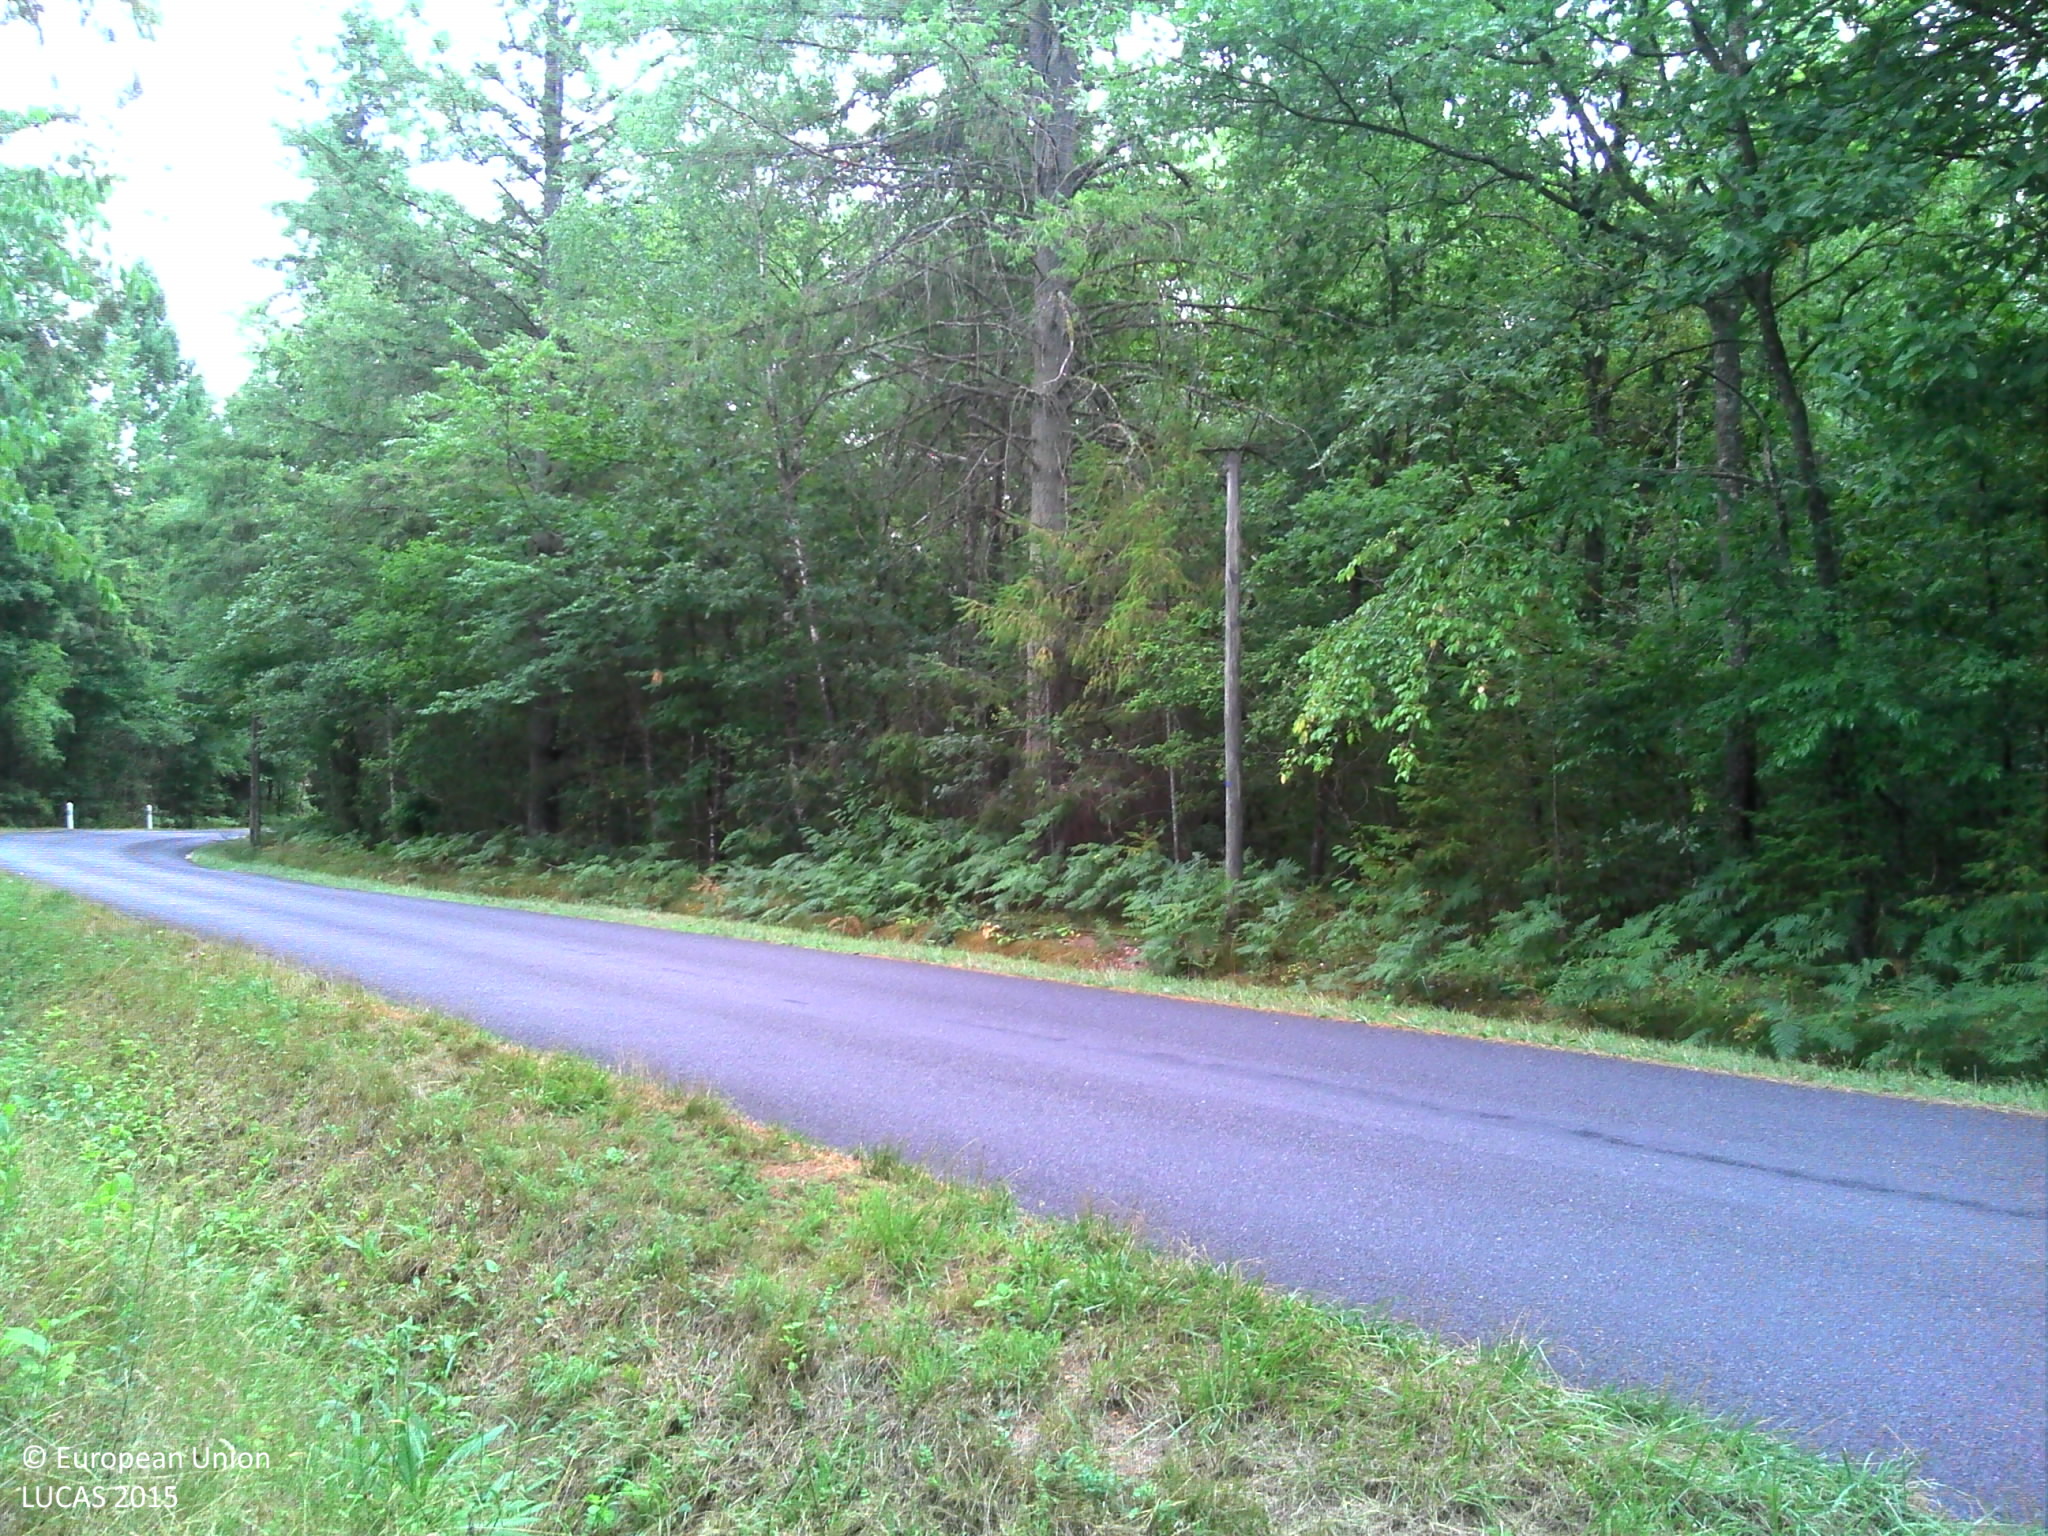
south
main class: Woodland
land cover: Broadleaved woodland
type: acidophilous oak and oak-birch forest
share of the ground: > 75 %
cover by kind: broadleaved forest trees 100 %
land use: Forestry
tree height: > 5 m
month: July
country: FR
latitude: 47.6820
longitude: 2.0362
